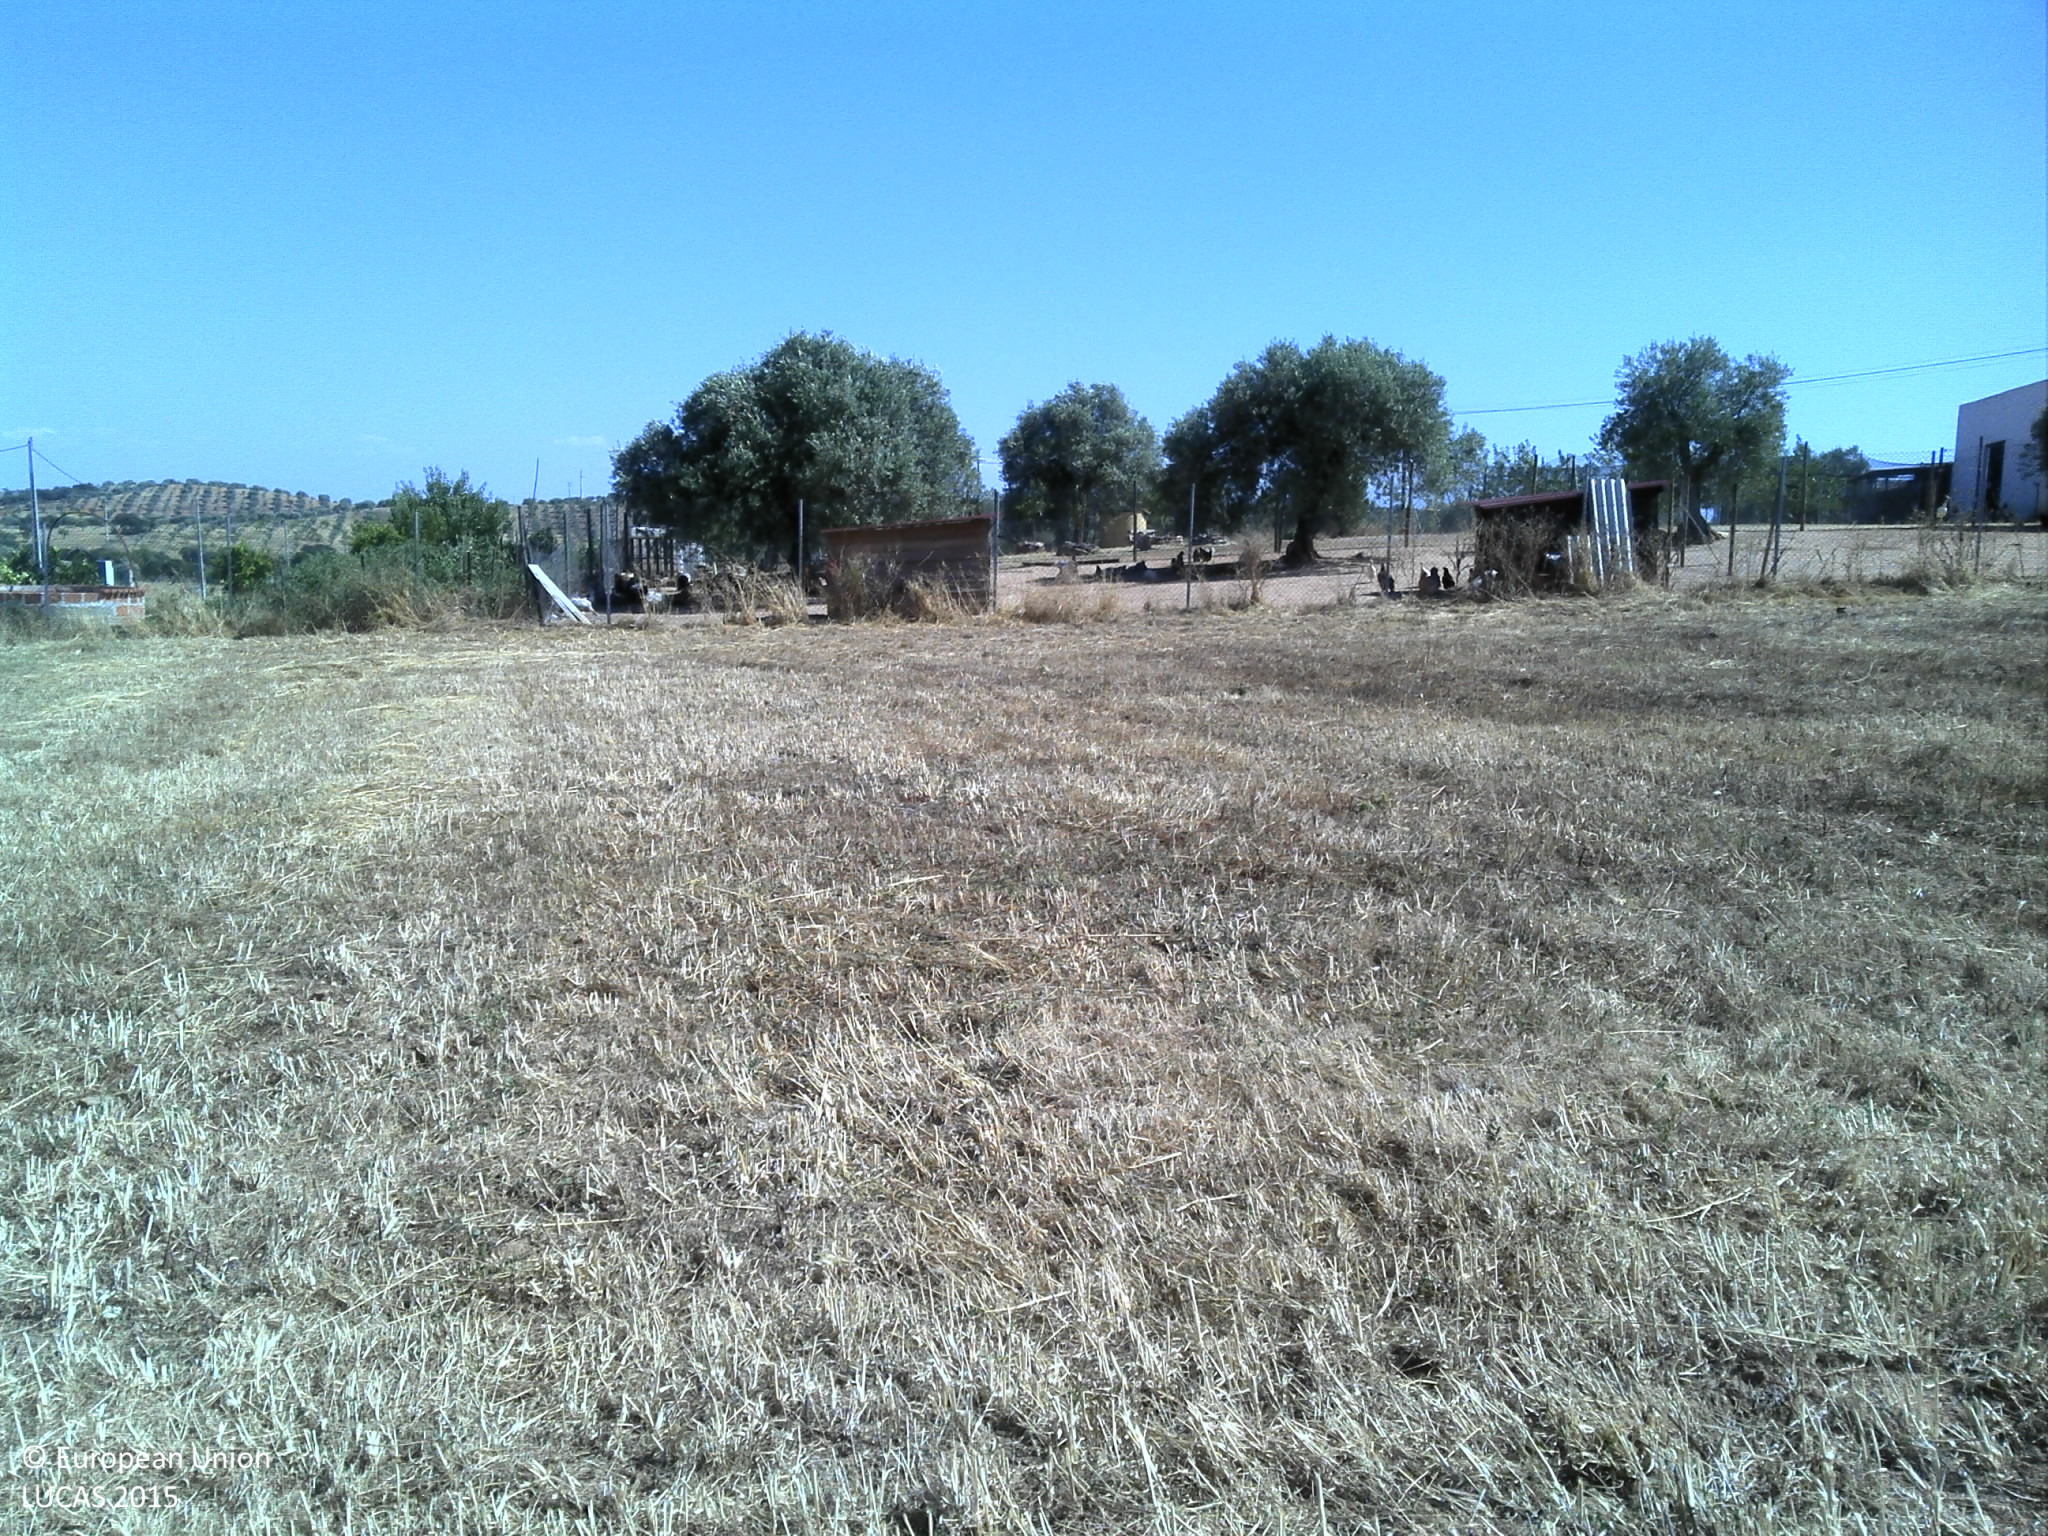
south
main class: Grassland
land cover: Grassland without tree/shrub cover
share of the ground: > 75 %
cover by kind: herbaceous plants 90 %, unconsolidated bare surface 10 %
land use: Agriculture (excluding fallow land and kitchen gardens)
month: June
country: PT
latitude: 37.9420
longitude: -7.2983
